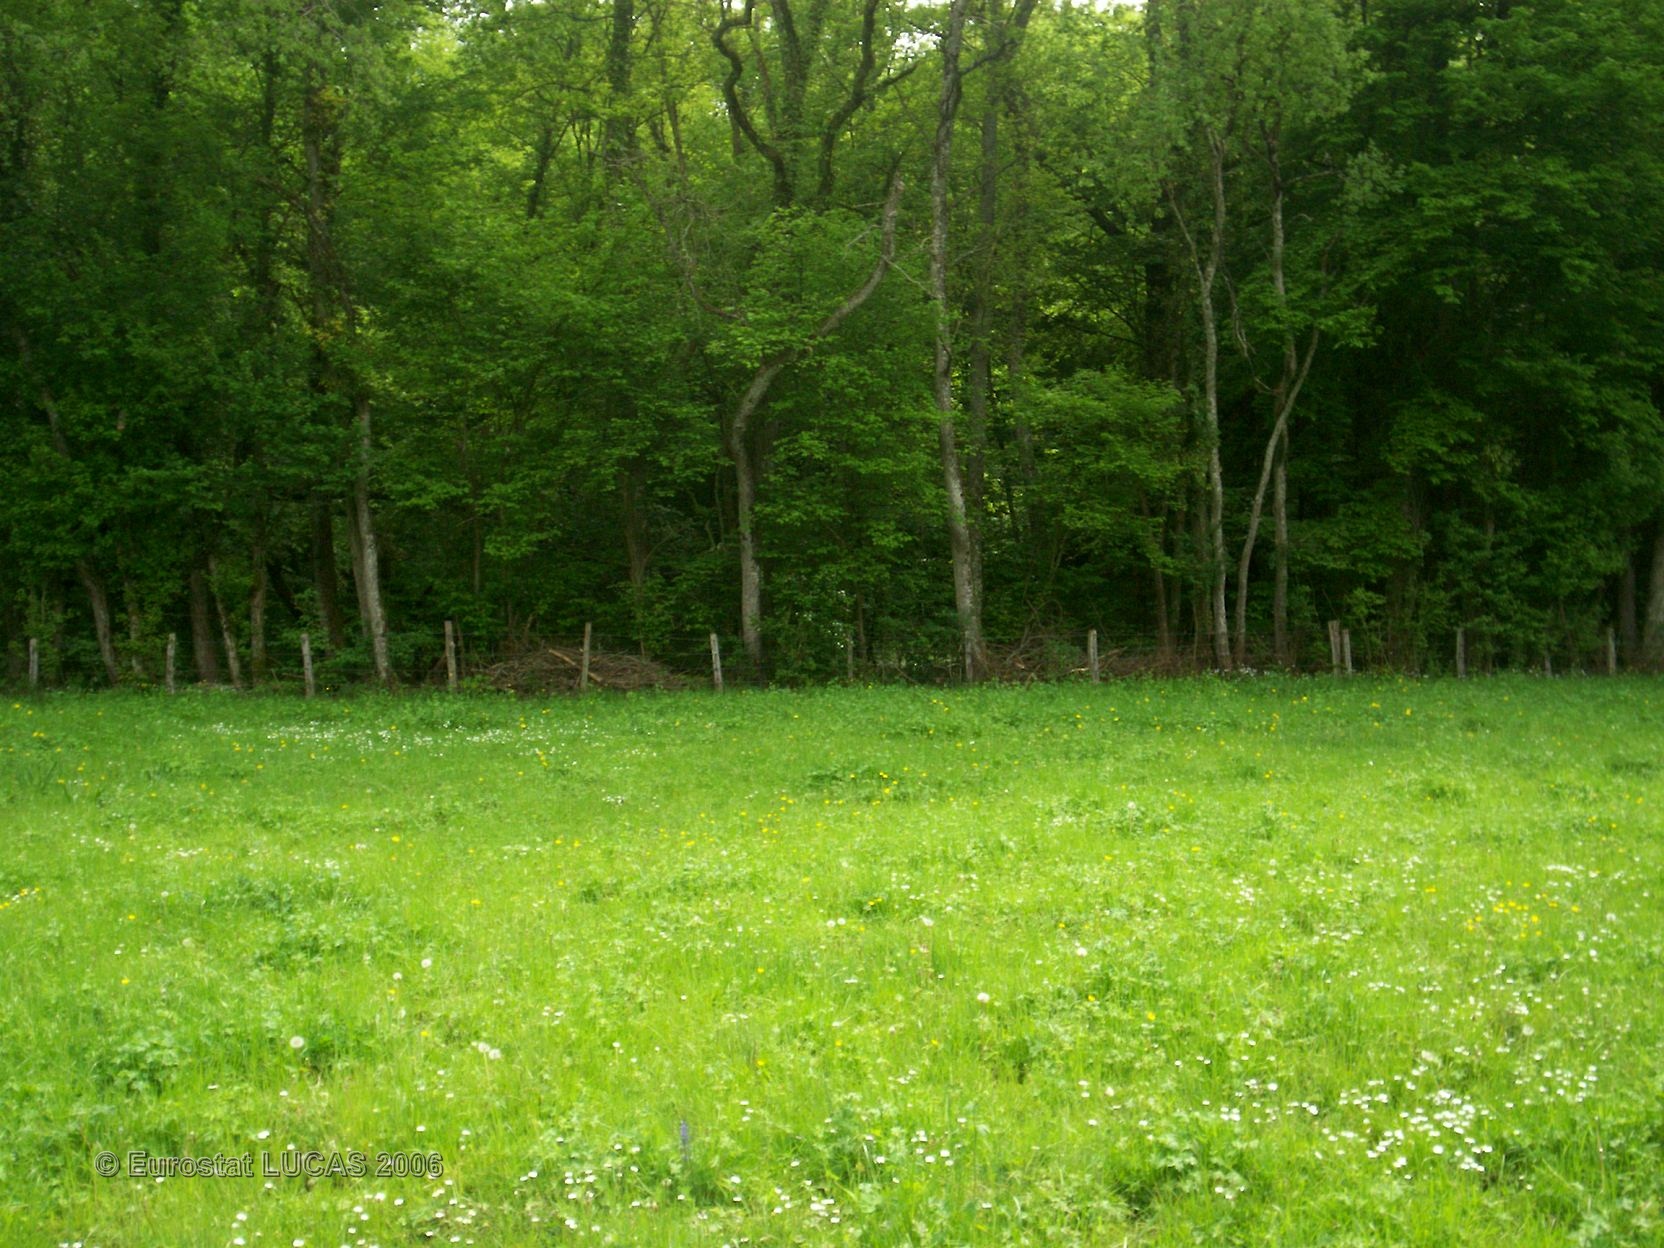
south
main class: Grassland
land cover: Grassland without tree/shrub cover
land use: Agriculture (excluding fallow land and kitchen gardens)
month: May
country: FR
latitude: 47.3164
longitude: 4.6154
